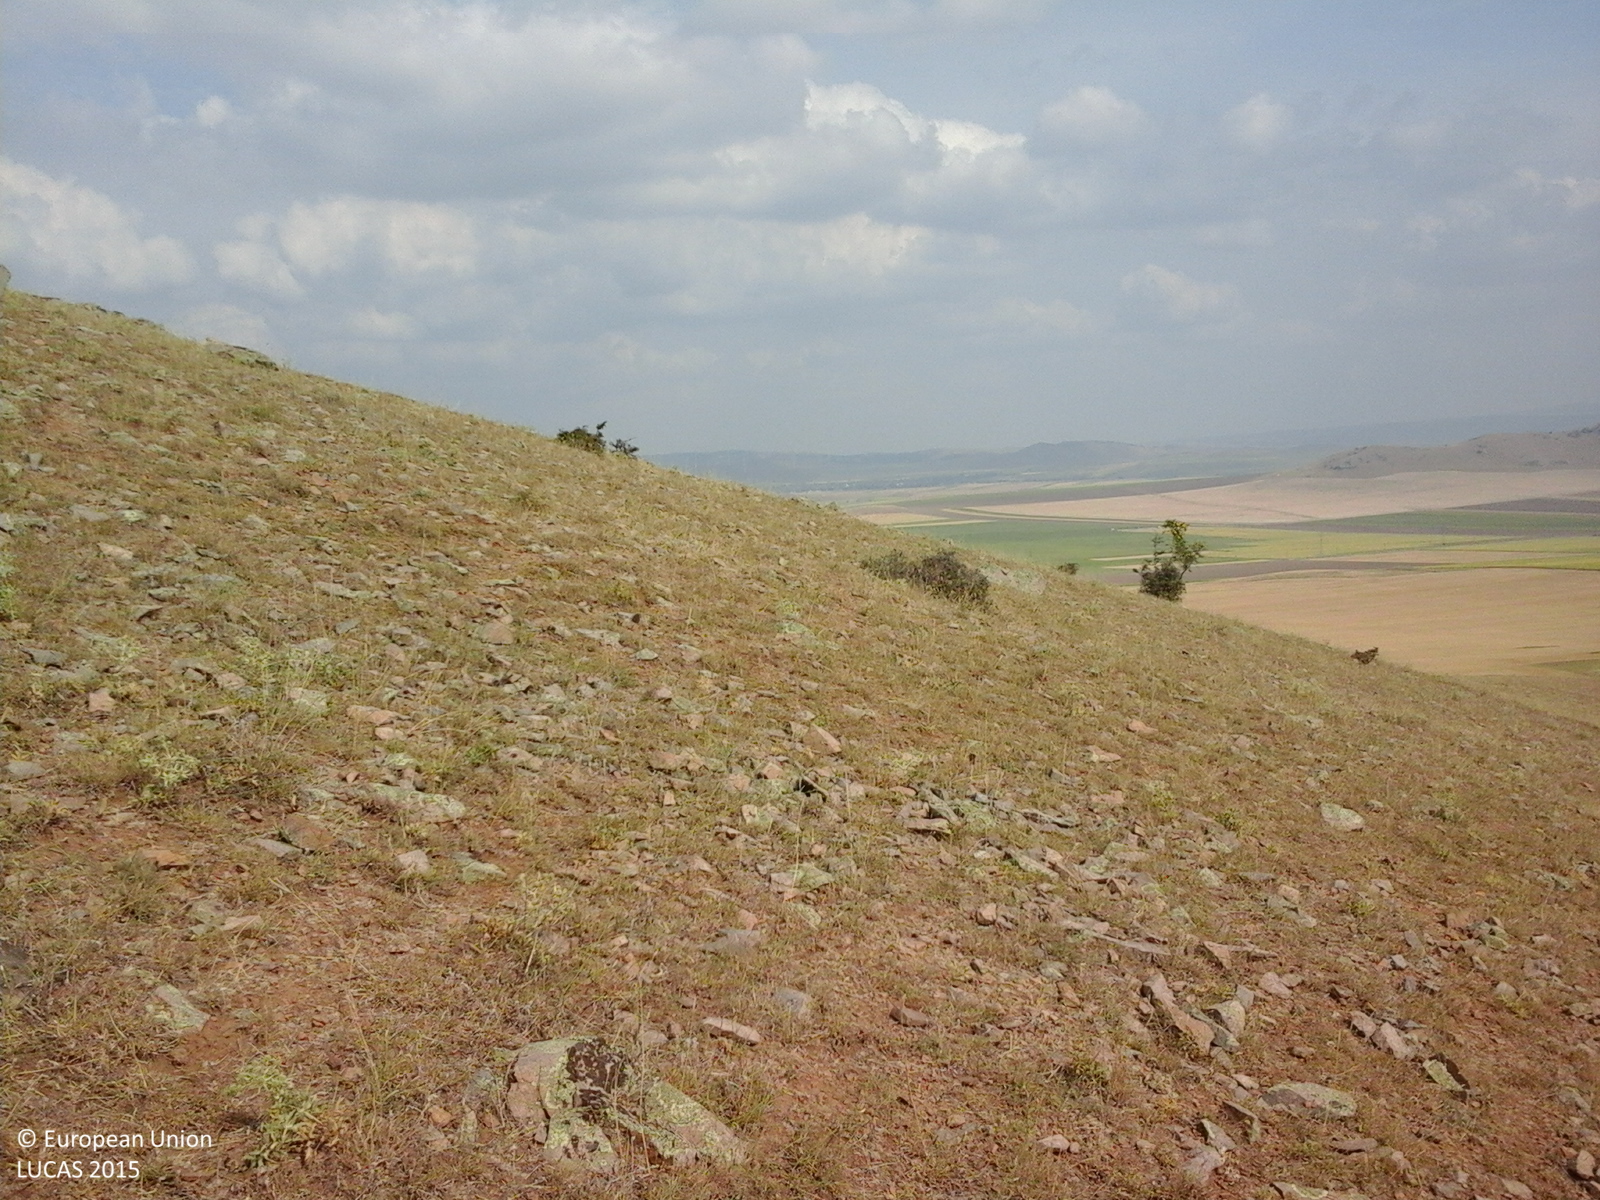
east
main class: Grassland
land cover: Grassland with sparse tree/shrub cover
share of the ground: > 75 %
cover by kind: herbaceous plants 90 %, broadleaved forest trees 5 %, shrubs 5 %
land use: Agriculture (excluding fallow land and kitchen gardens)
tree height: < 5 m
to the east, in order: Grassland with sparse tree/shrub cover
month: July
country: RO
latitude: 45.1037
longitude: 28.2050
